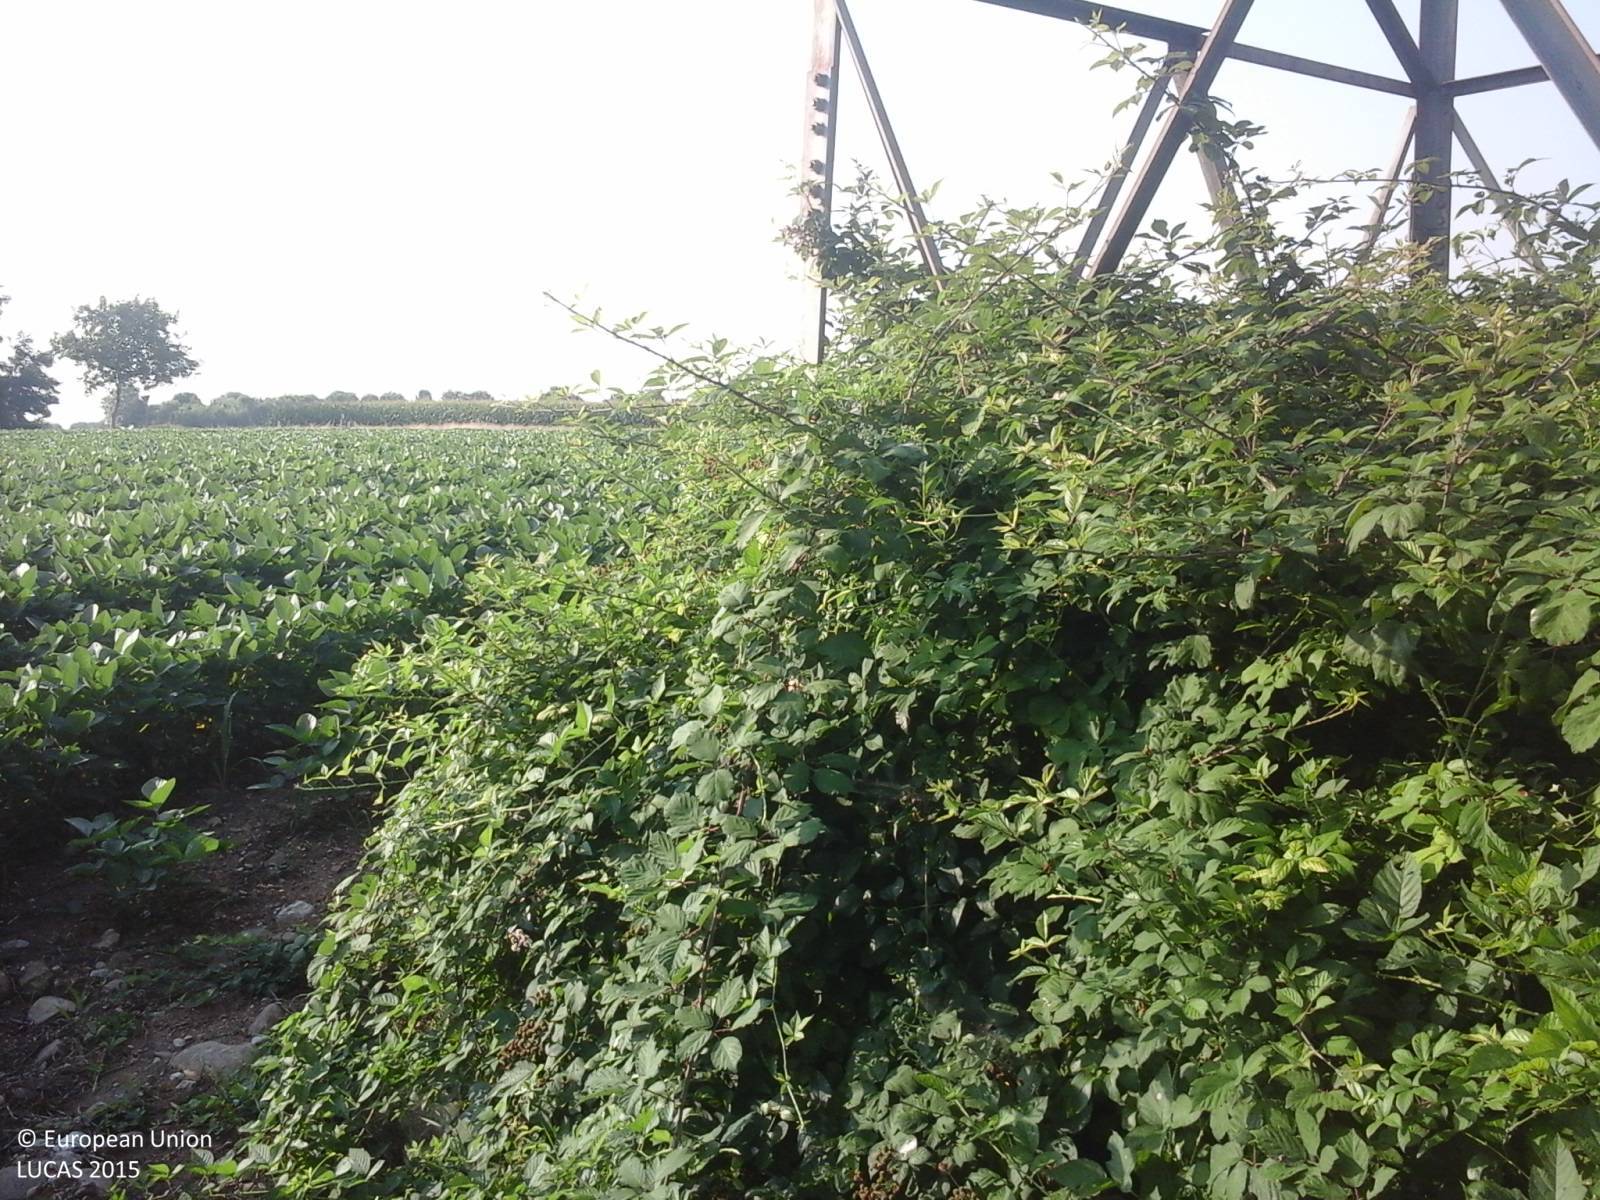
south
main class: Woodland
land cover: Broadleaved woodland
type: thermophilous deciduous forest
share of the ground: > 75 %
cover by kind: broadleaved forest trees 60 %, shrubs 40 %
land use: Forestry
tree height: > 5 m
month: July
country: IT
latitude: 46.1091
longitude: 13.0628
